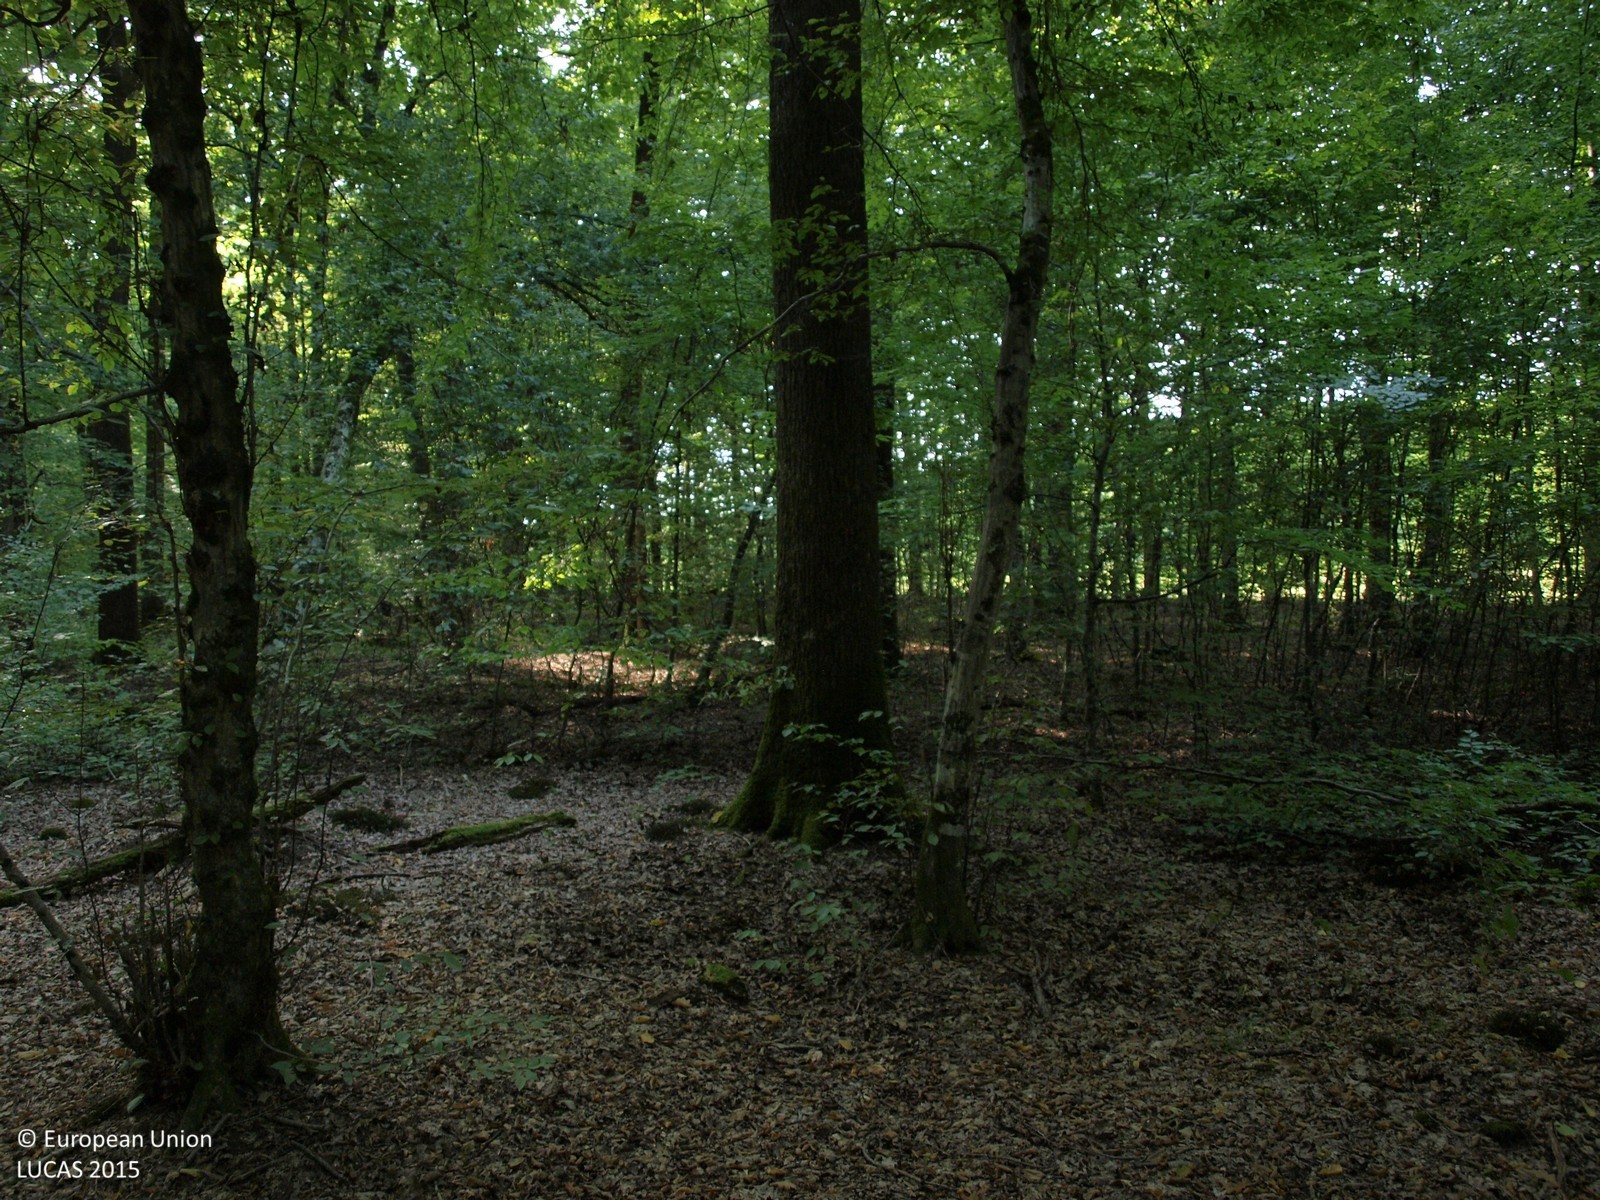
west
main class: Woodland
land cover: Broadleaved woodland
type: mesophytic deciduous forest
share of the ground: > 75 %
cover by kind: broadleaved forest trees 100 %
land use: Forestry
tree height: > 5 m
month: September
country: HR
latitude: 45.6177
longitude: 16.0892
